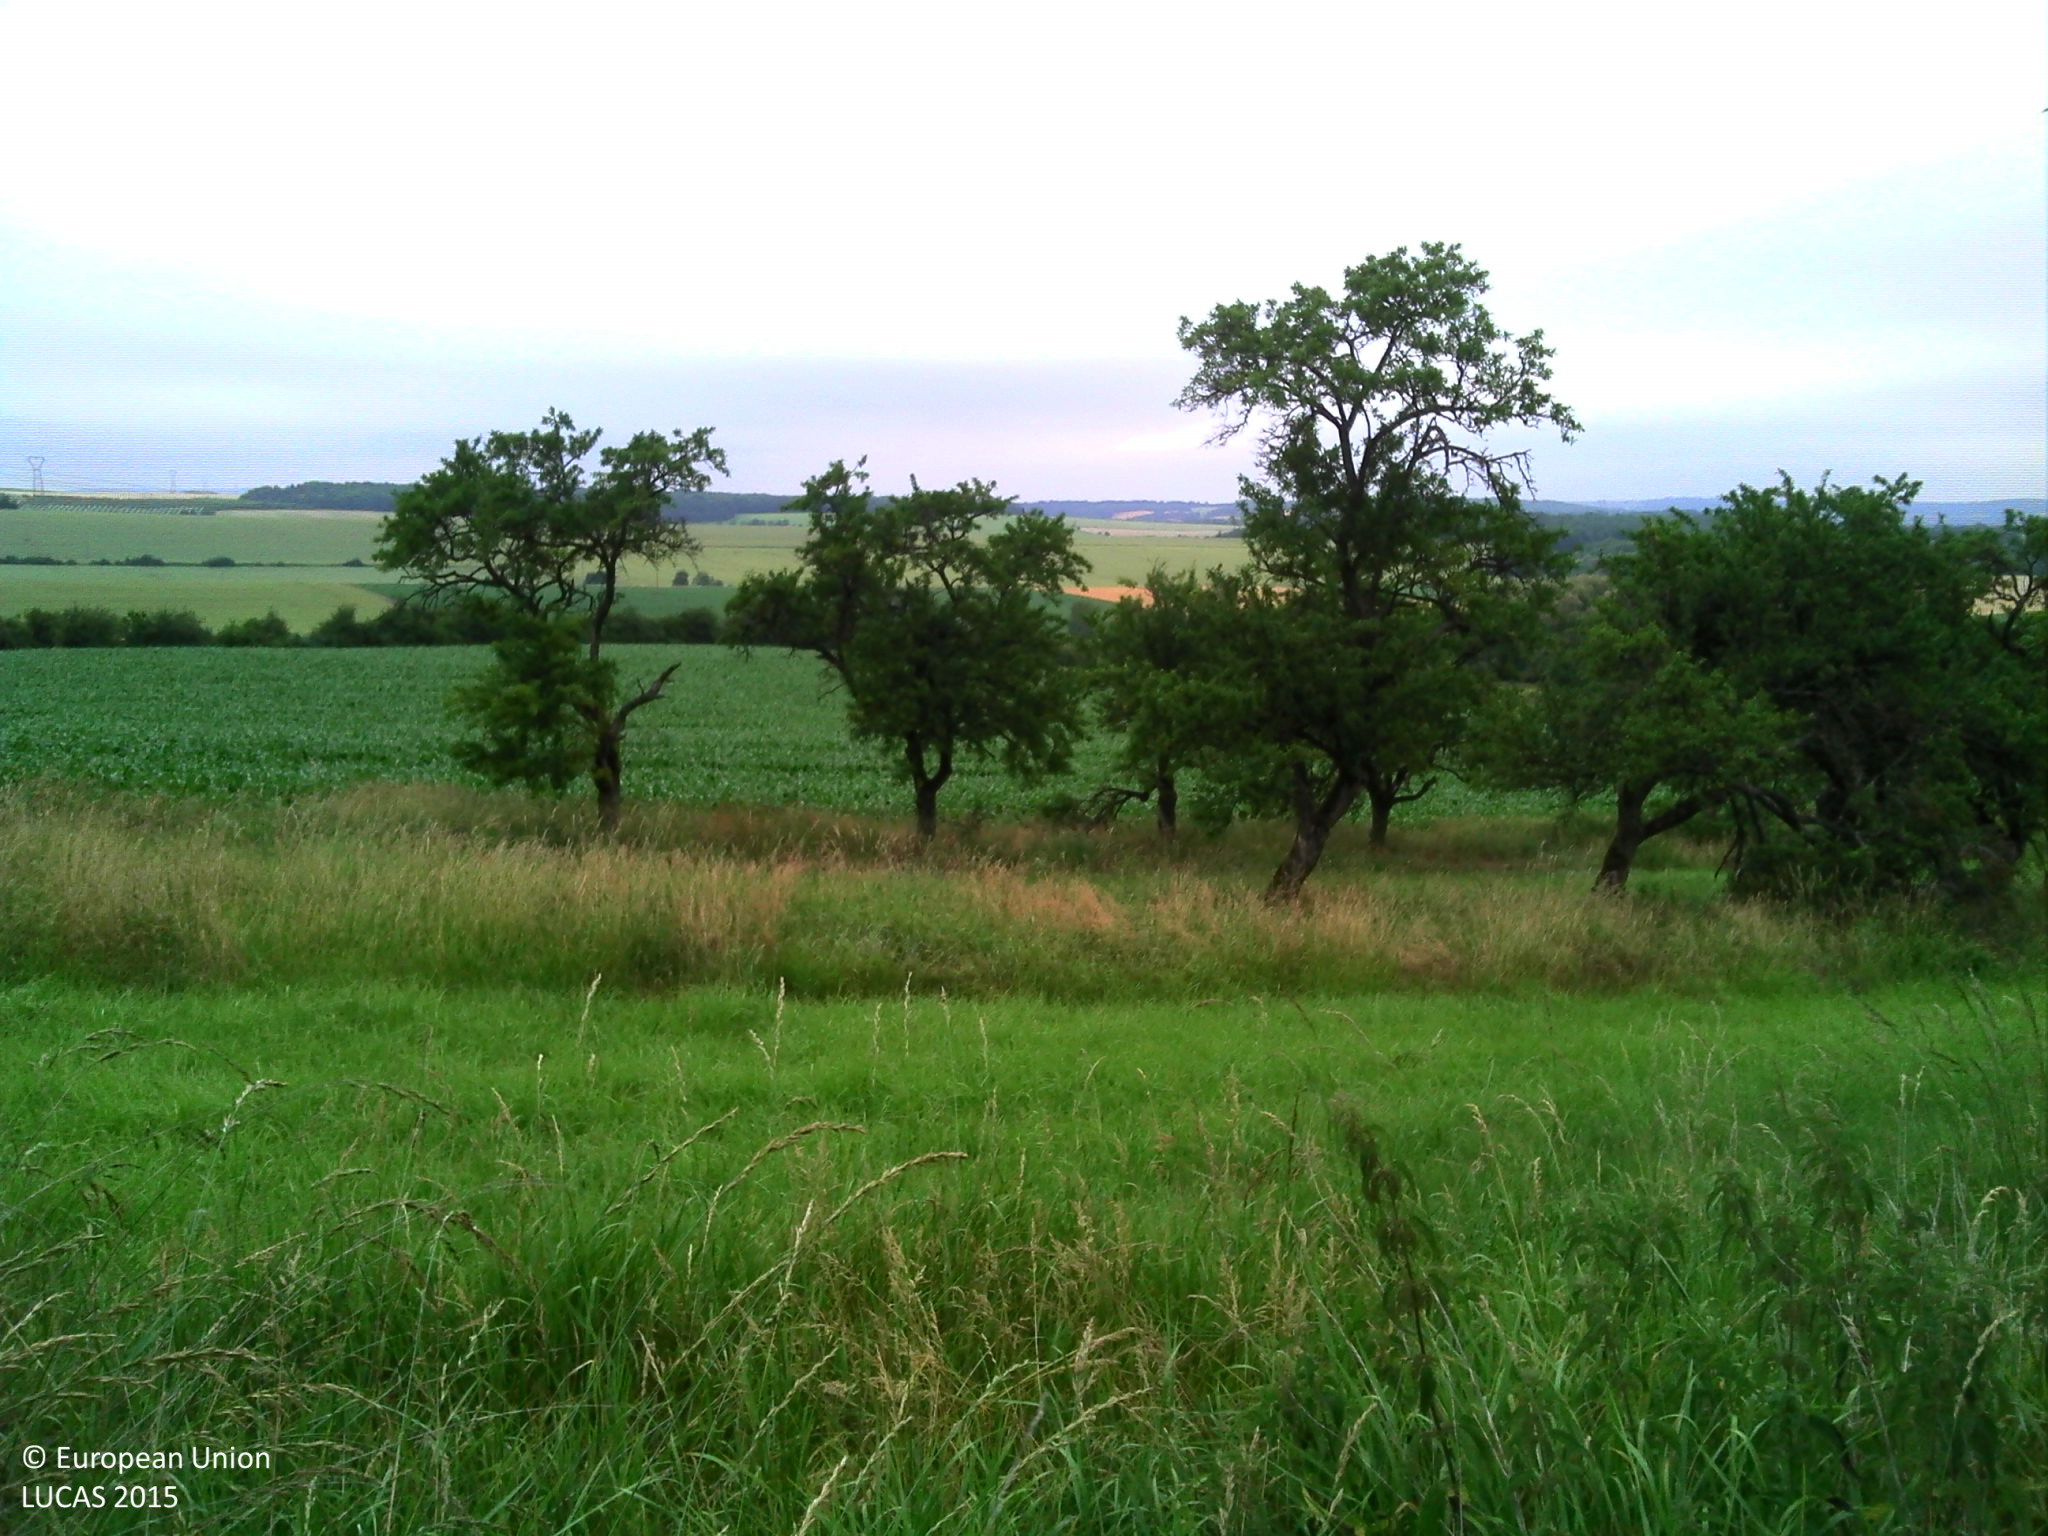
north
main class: Grassland
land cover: Grassland without tree/shrub cover
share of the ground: > 75 %
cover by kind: herbaceous plants 100 %
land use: Agriculture (excluding fallow land and kitchen gardens)
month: June
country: FR
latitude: 48.5578
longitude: 6.3013
